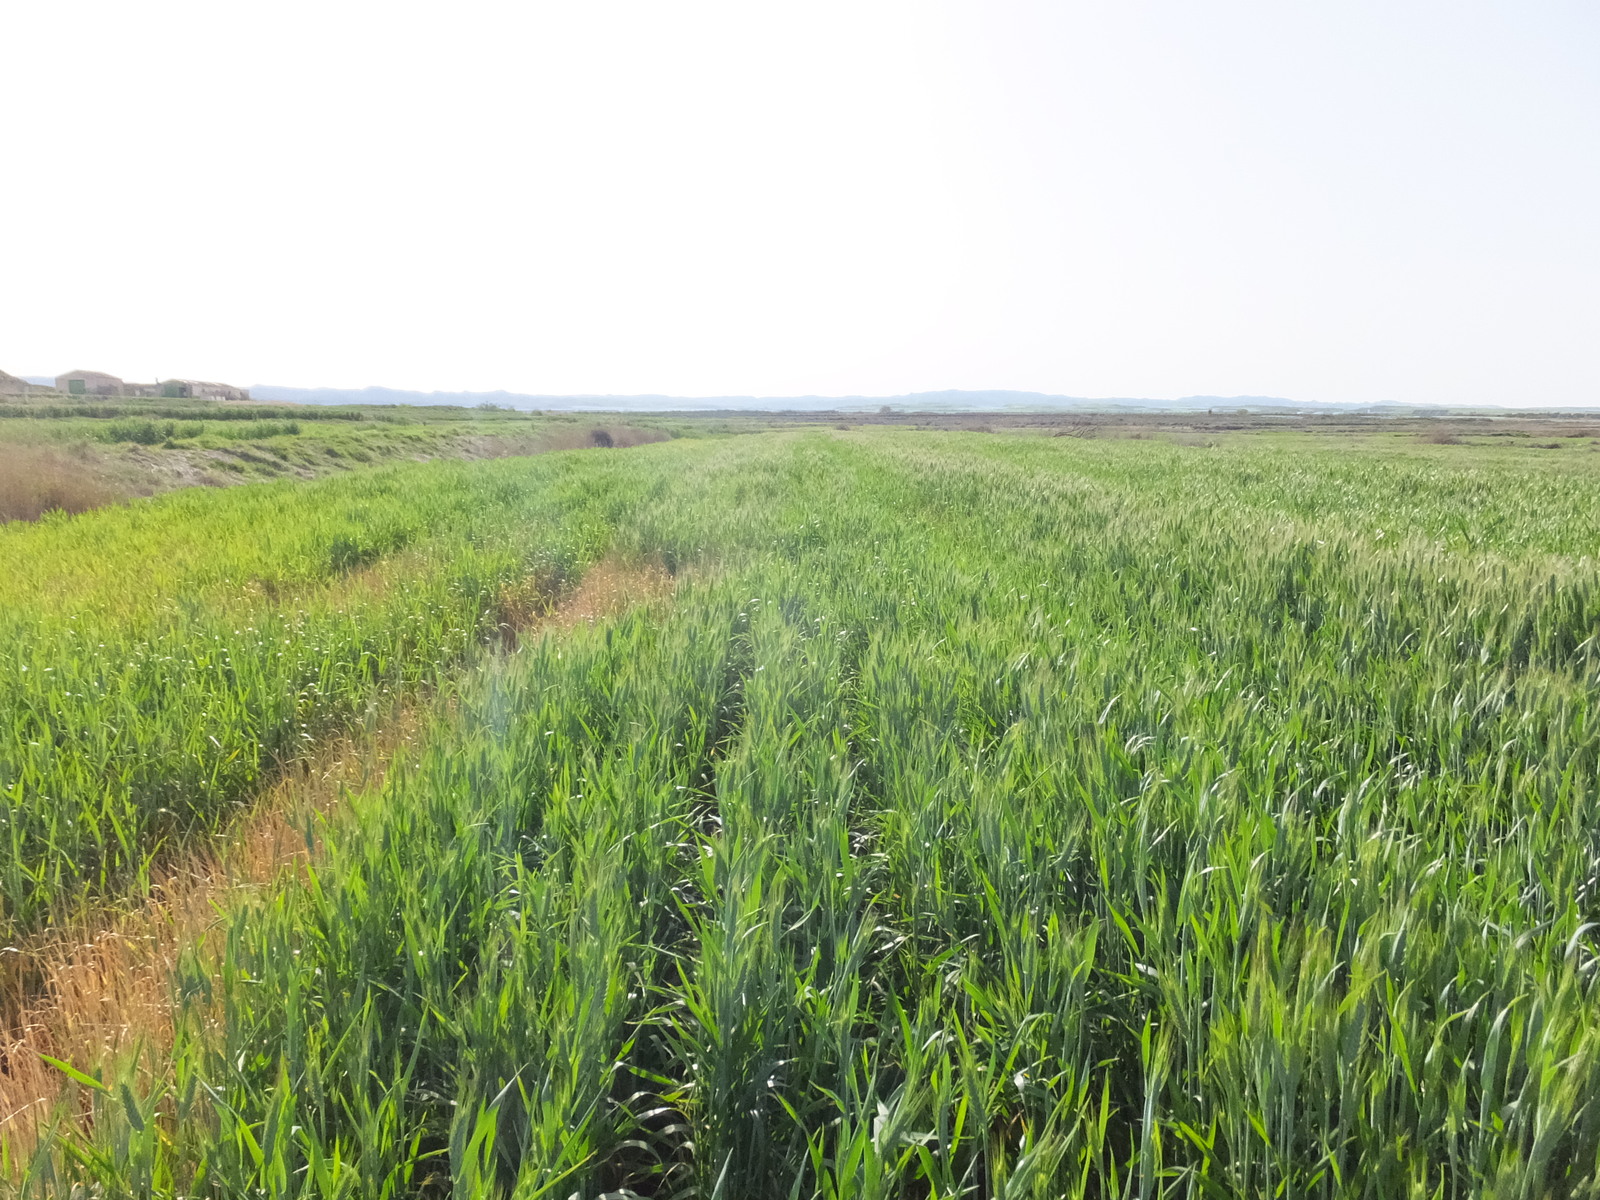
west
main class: Cropland
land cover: Durum wheat
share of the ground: > 75 %
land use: Agriculture (excluding fallow land and kitchen gardens)
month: April
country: ES
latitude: 41.7763
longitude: -0.3535
